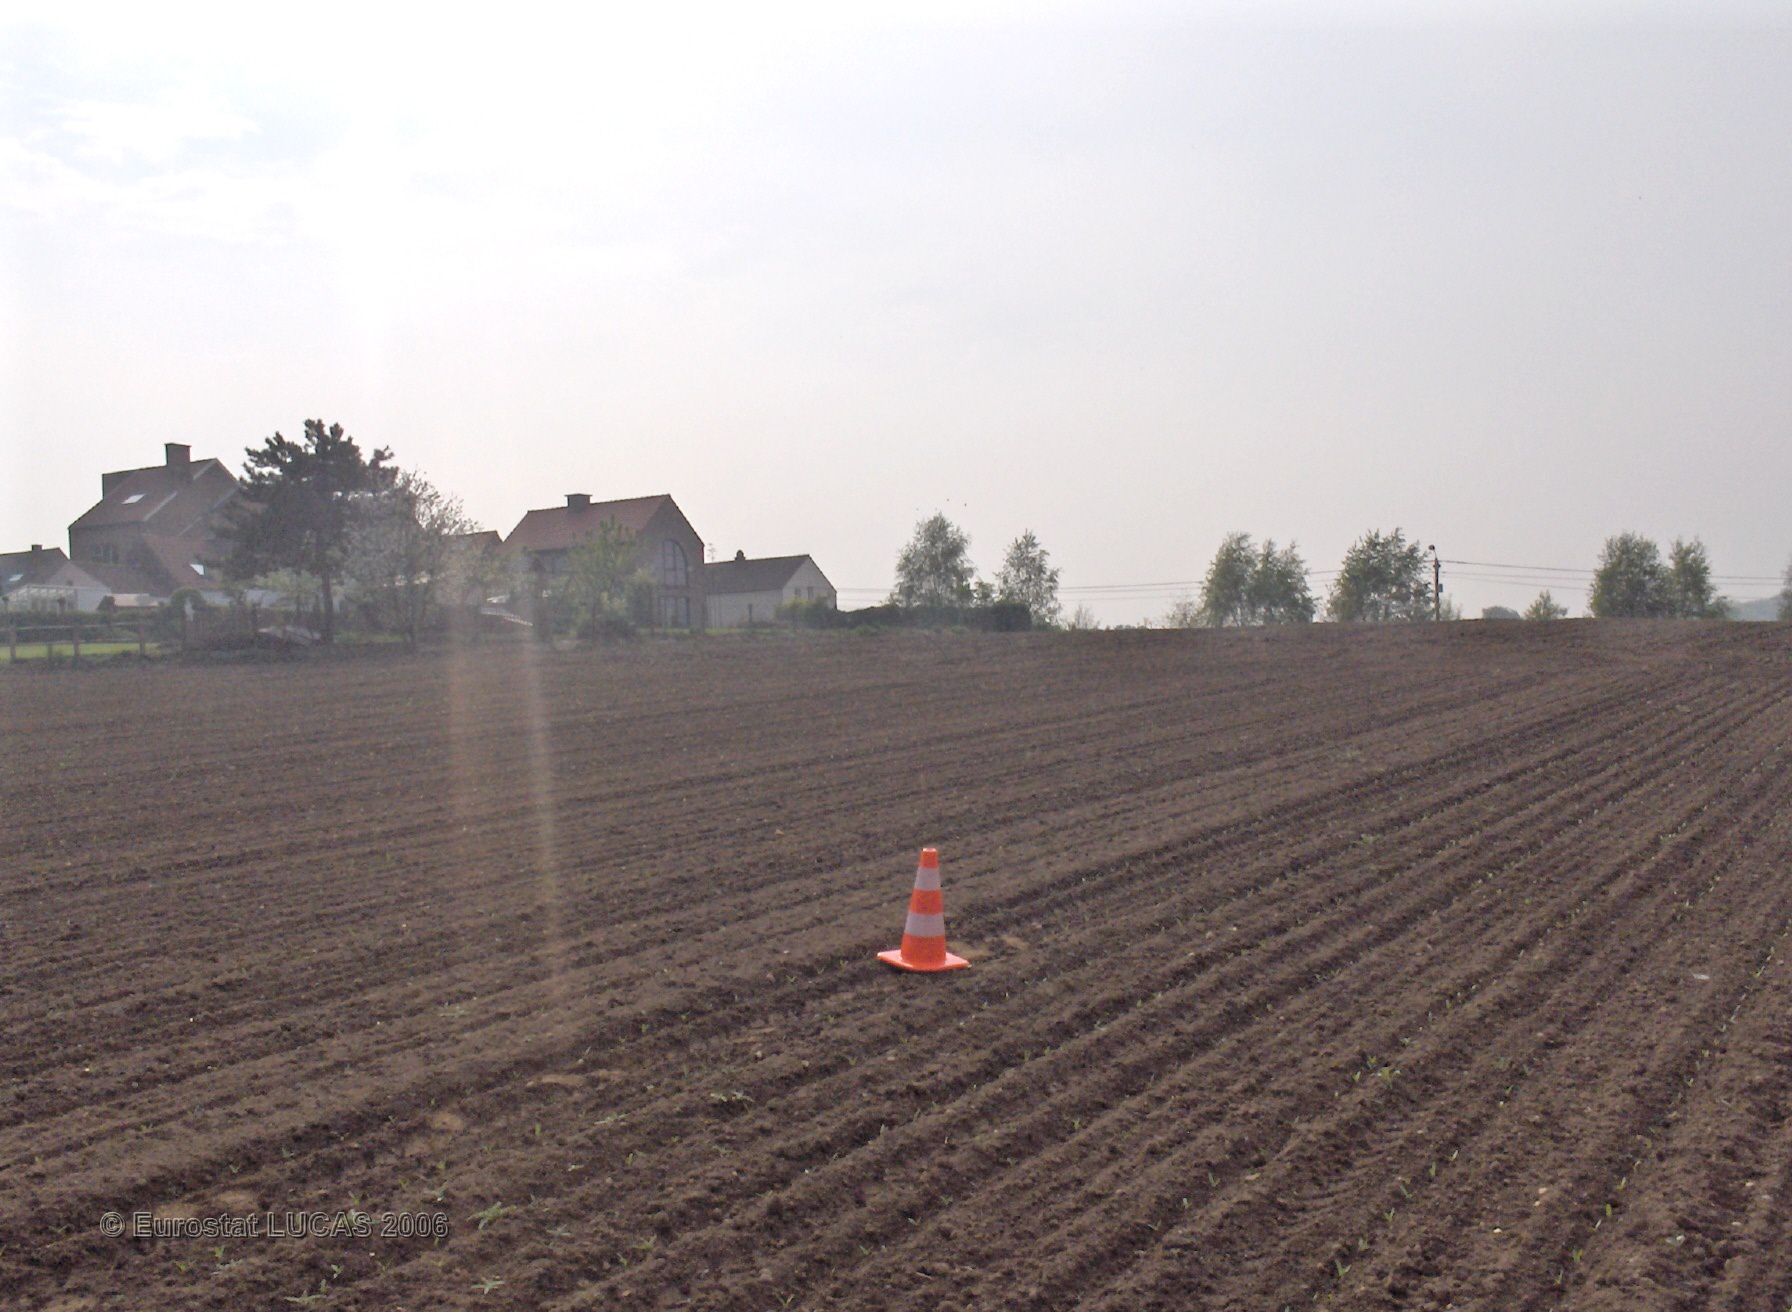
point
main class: Cropland
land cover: Sugar beet
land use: Agriculture (excluding fallow land and kitchen gardens)
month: May
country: BE
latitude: 50.6626
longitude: 4.4642
